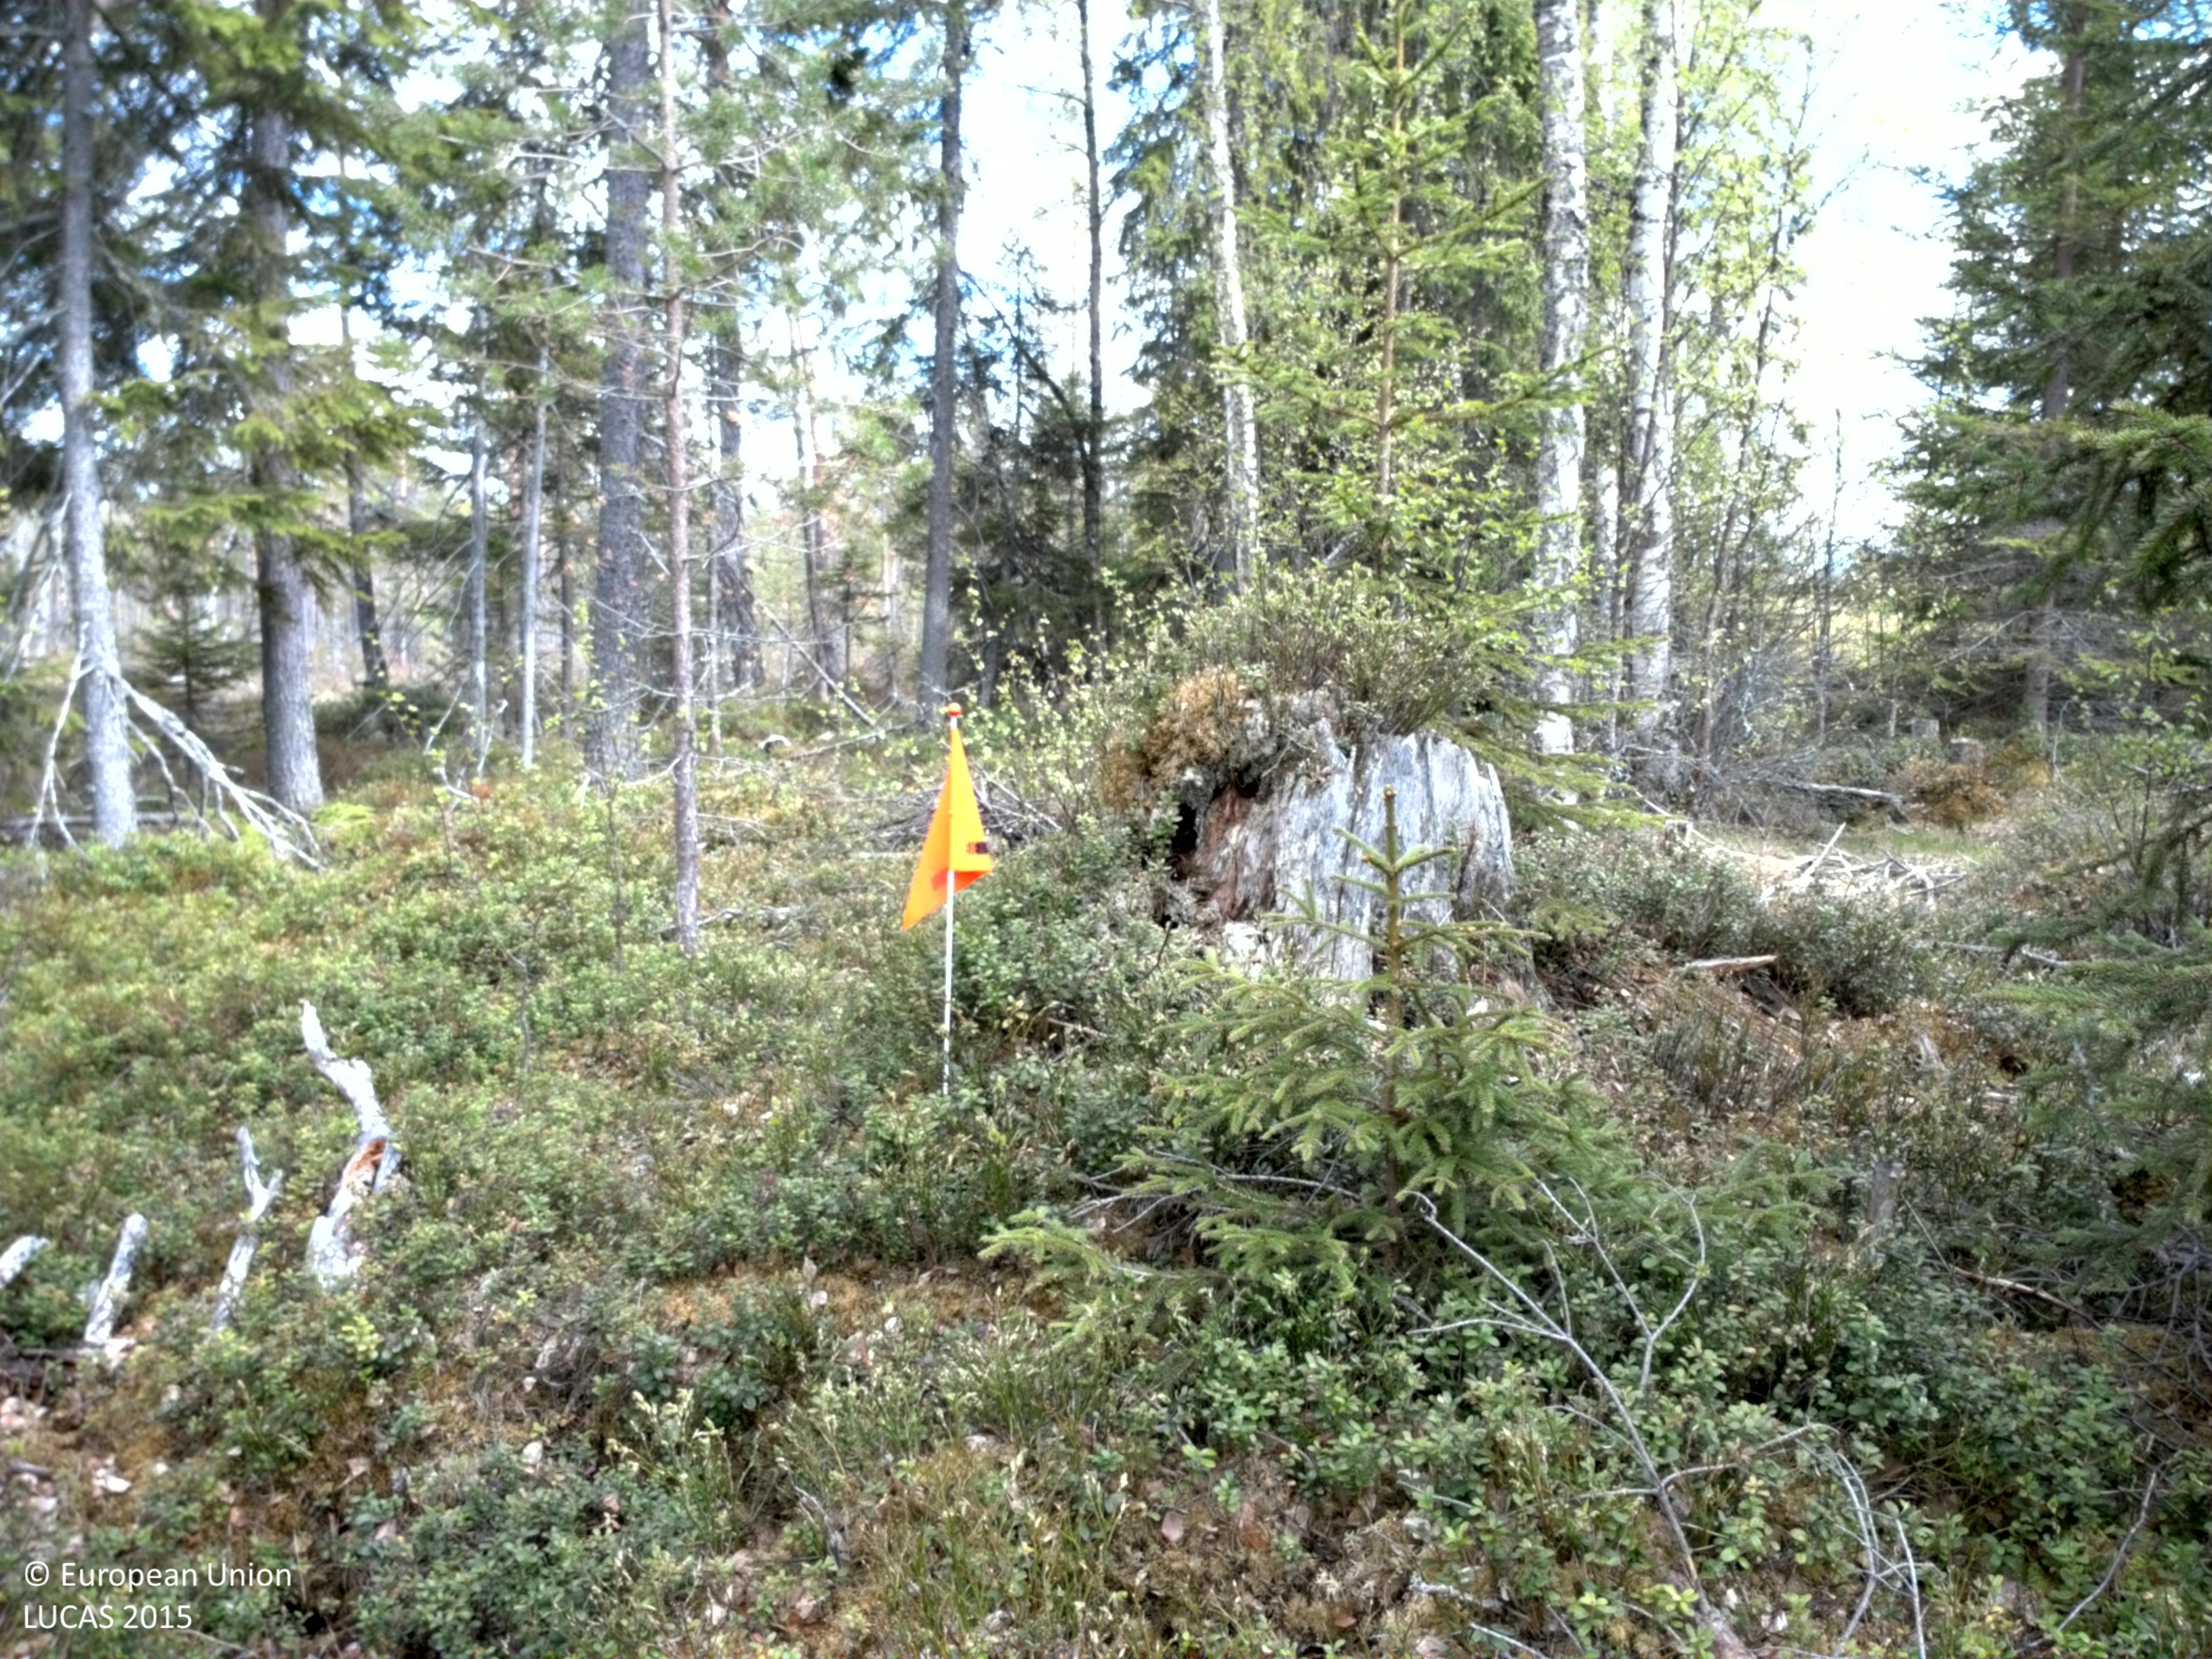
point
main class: Woodland
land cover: Spruce dominated mixed woodland
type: boreal forest
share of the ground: 50 - 75 %
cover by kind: shrubs 35 %, coniferous forest trees 30 %, broadleaved forest trees 25 %, lichens and mosses 10 %
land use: Forestry
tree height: > 5 m
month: May
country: SE
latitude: 61.1207
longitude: 15.4981
